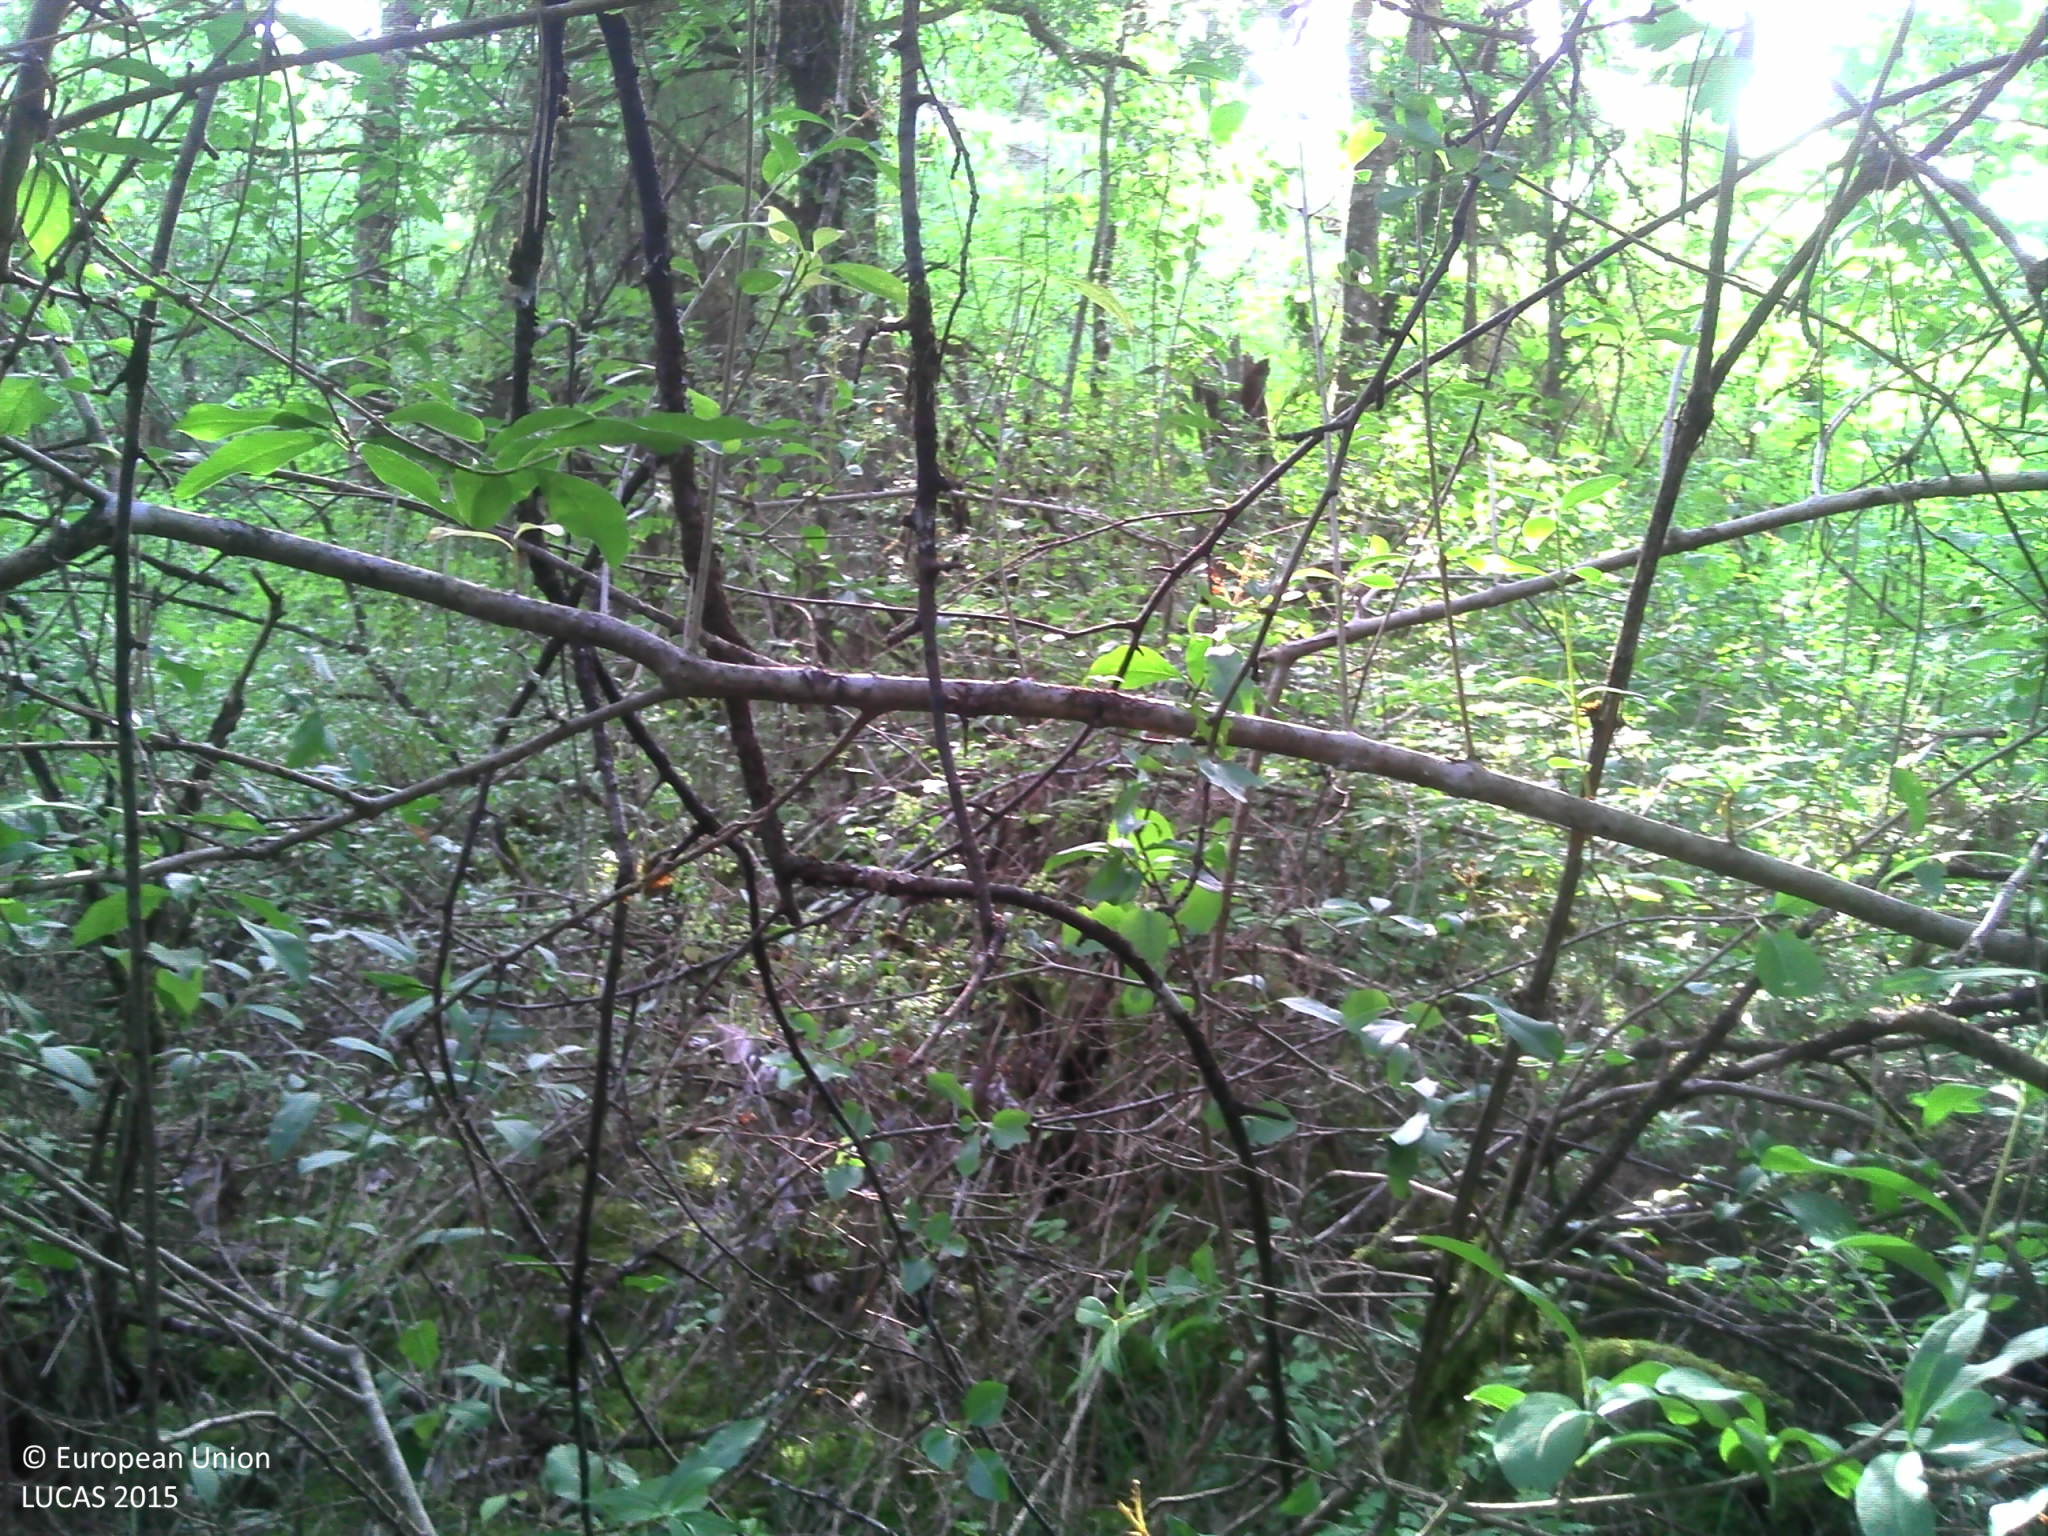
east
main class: Woodland
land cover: Pine dominated coniferous woodland
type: mesophytic deciduous forest
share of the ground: > 75 %
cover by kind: coniferous forest trees 80 %, broadleaved forest trees 10 %, herbaceous plants 5 %, lichens and mosses 5 %
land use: Semi-natural and natural areas not in use
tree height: > 5 m
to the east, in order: Pine dominated coniferous woodland; Pine dominated mixed woodland; Tracks; Pine dominated mixed woodland; Broadleaved woodland; Barley
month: July
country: FR
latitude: 47.6743
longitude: 3.5628
